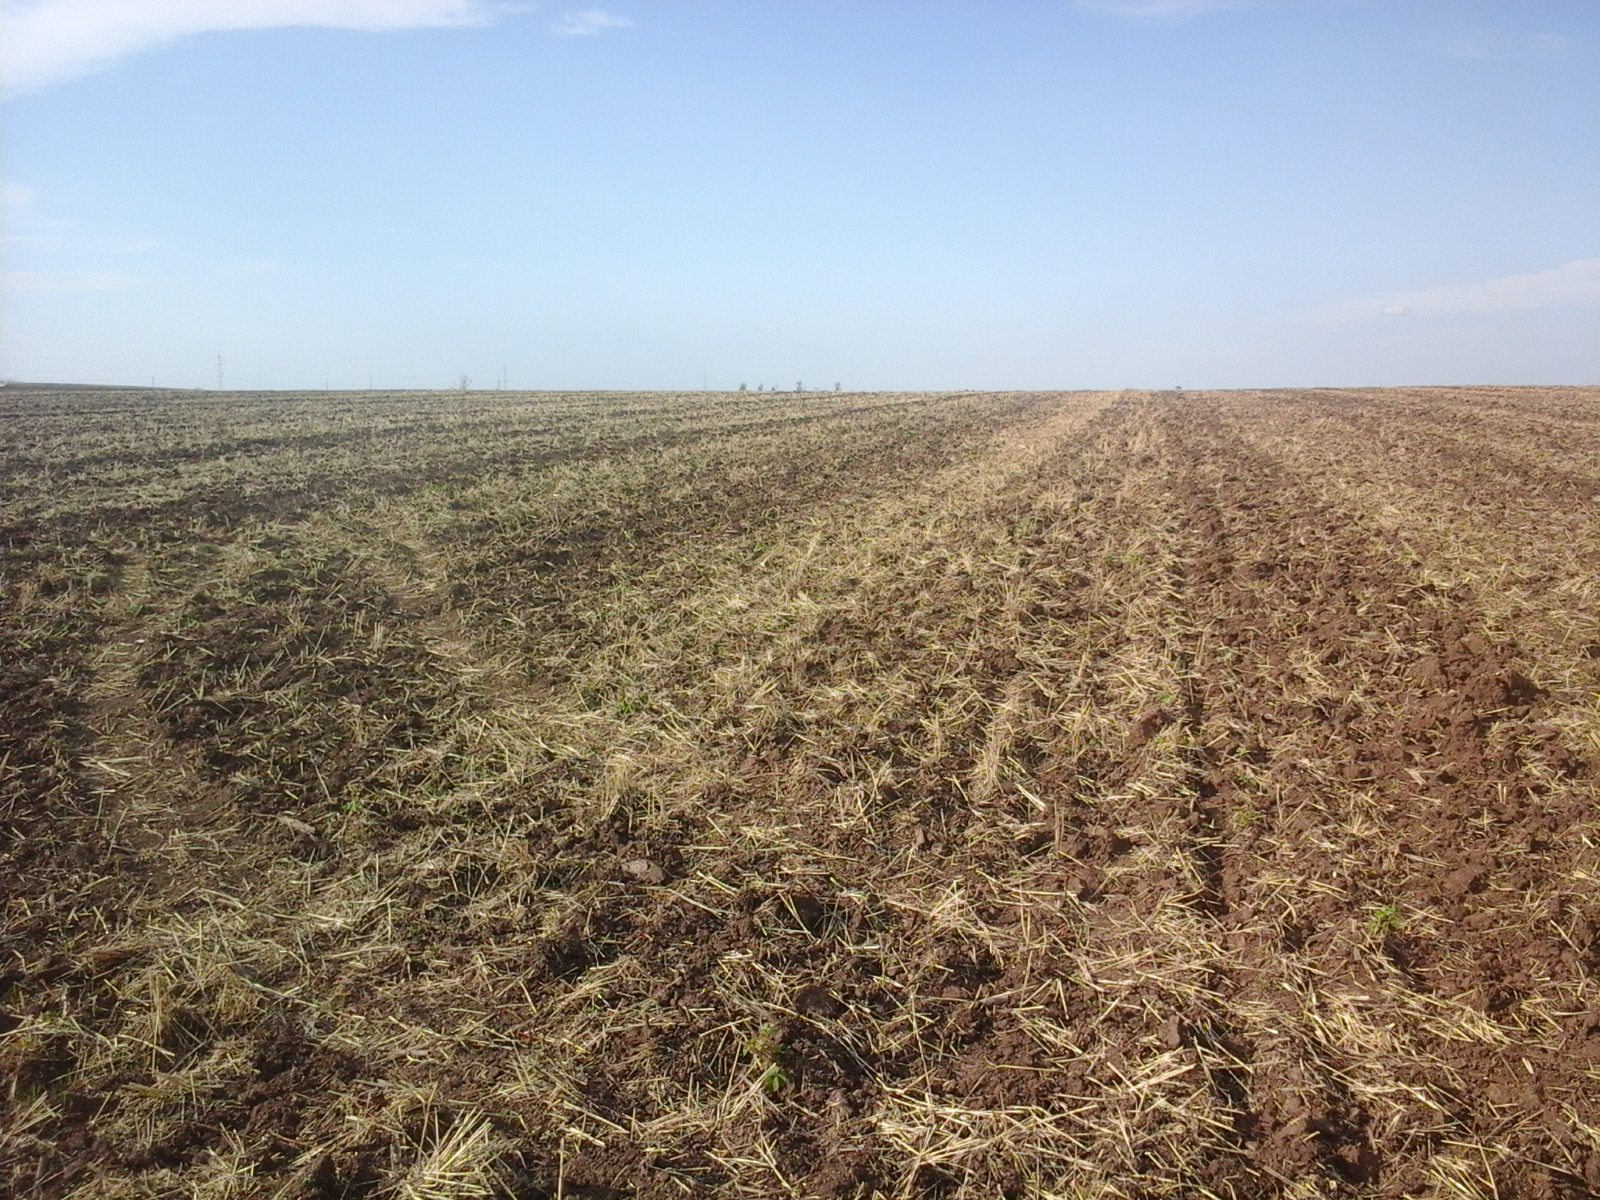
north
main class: Cropland
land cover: Common wheat
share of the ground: < 10 %
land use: Agriculture (excluding fallow land and kitchen gardens)
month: October
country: RO
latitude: 46.0575
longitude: 21.3175
